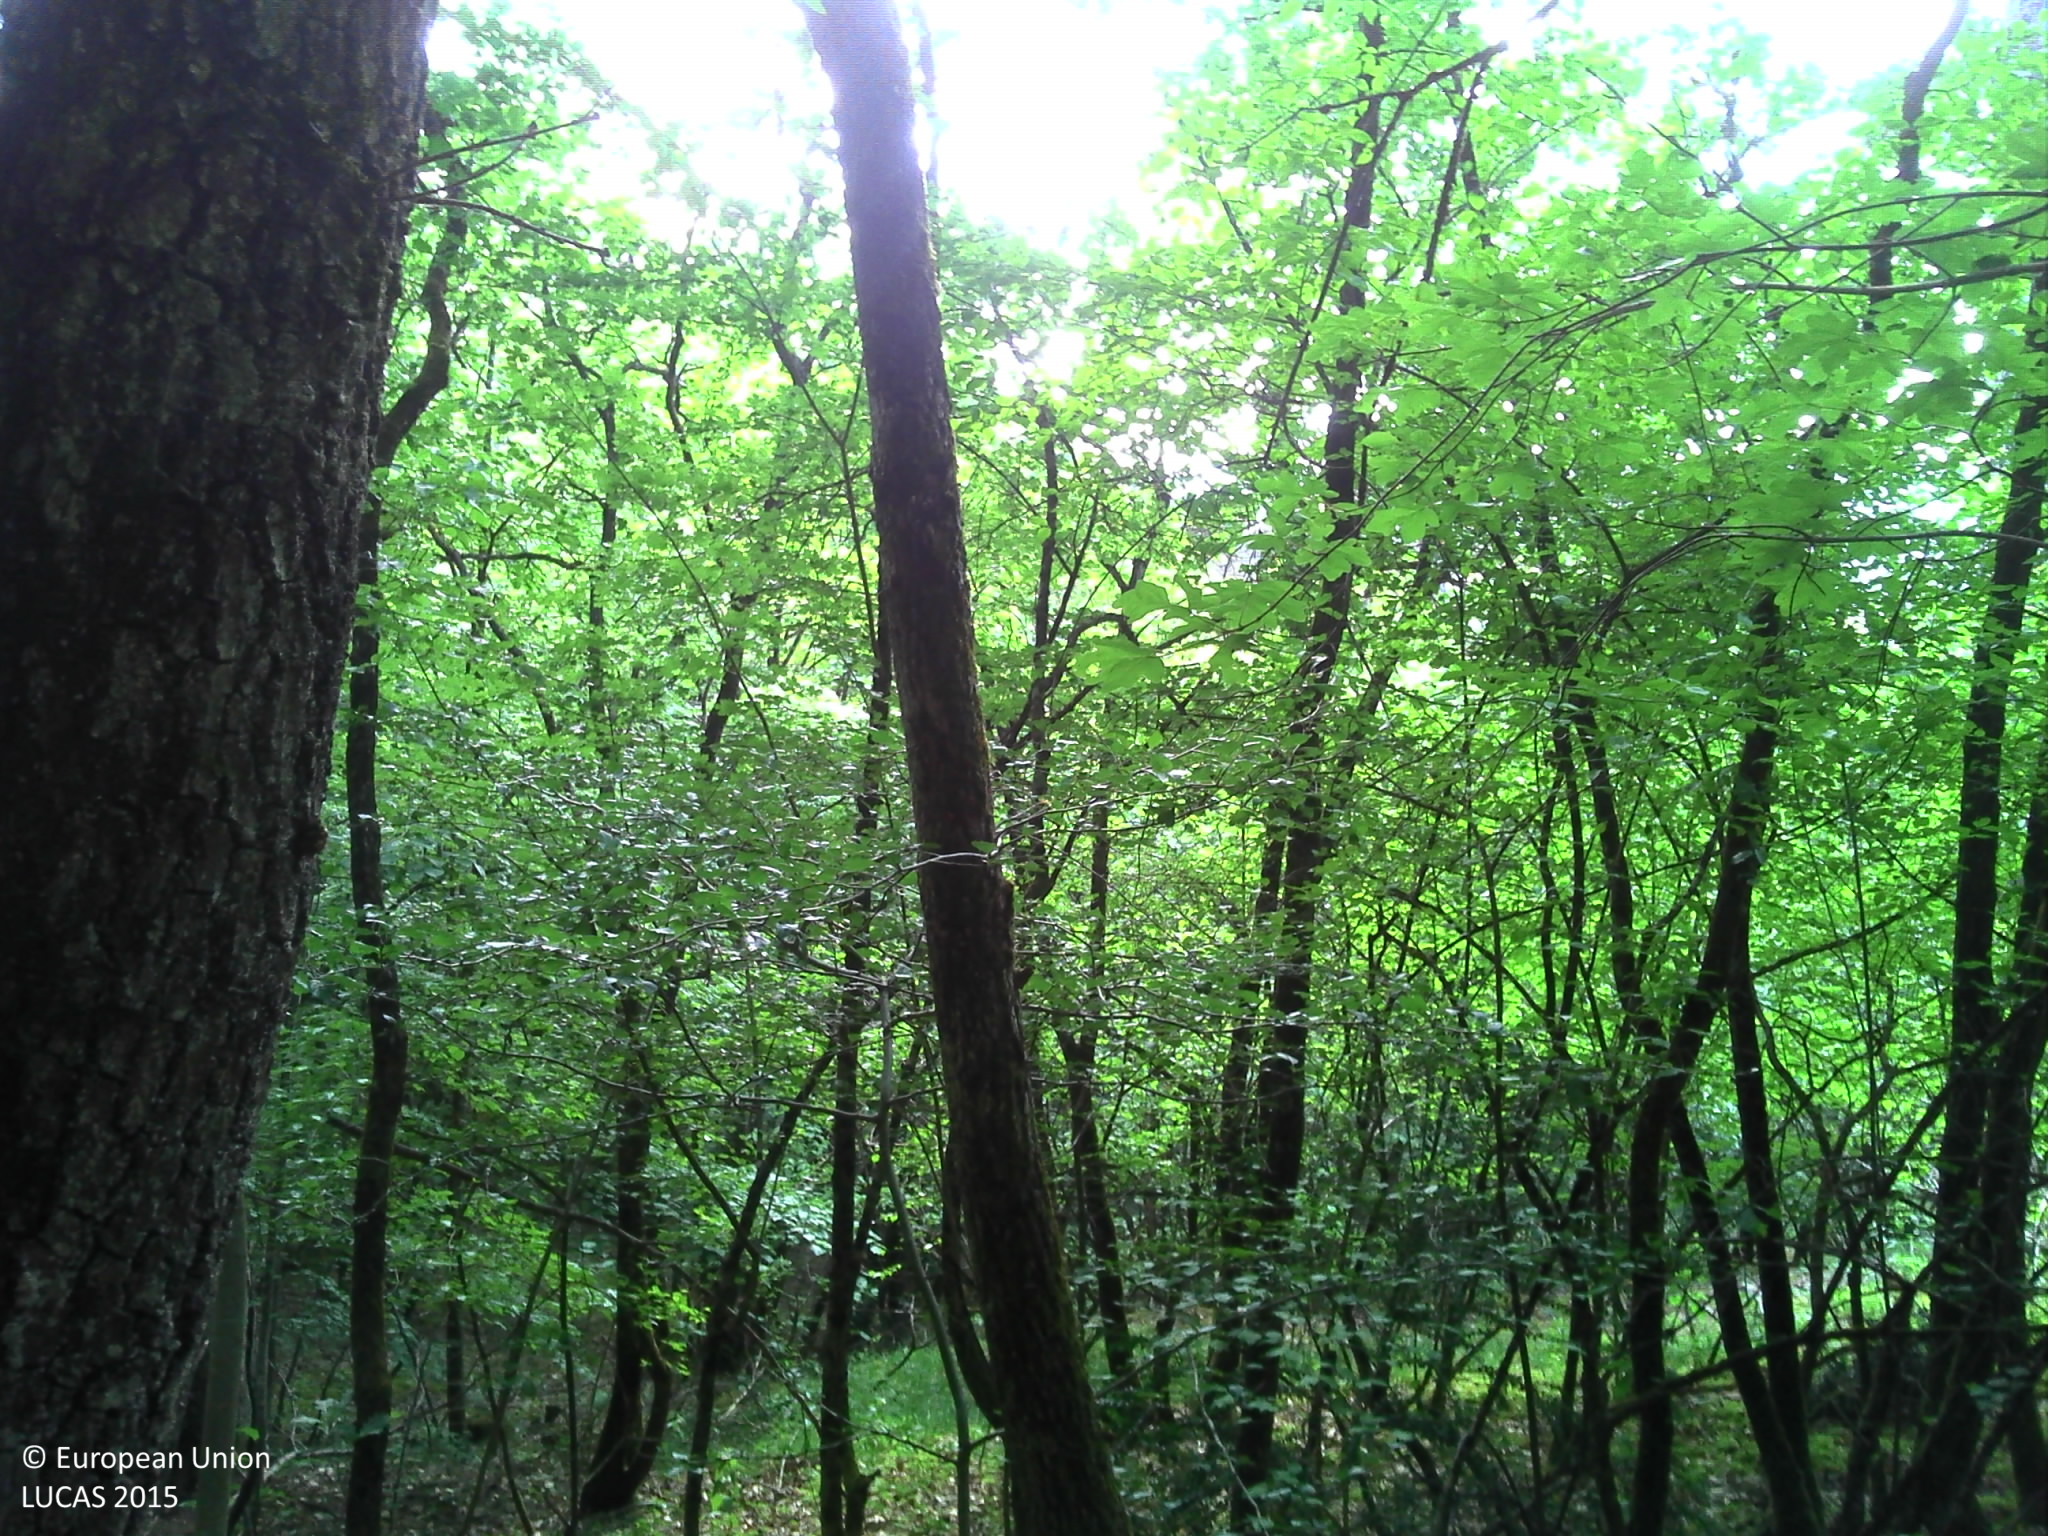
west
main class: Woodland
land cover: Pine dominated mixed woodland
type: mesophytic deciduous forest
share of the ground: > 75 %
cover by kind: broadleaved forest trees 55 %, coniferous forest trees 25 %, herbaceous plants 15 %, lichens and mosses 5 %
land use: Forestry
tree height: > 5 m
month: May
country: FR
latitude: 47.3137
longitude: 4.9338
